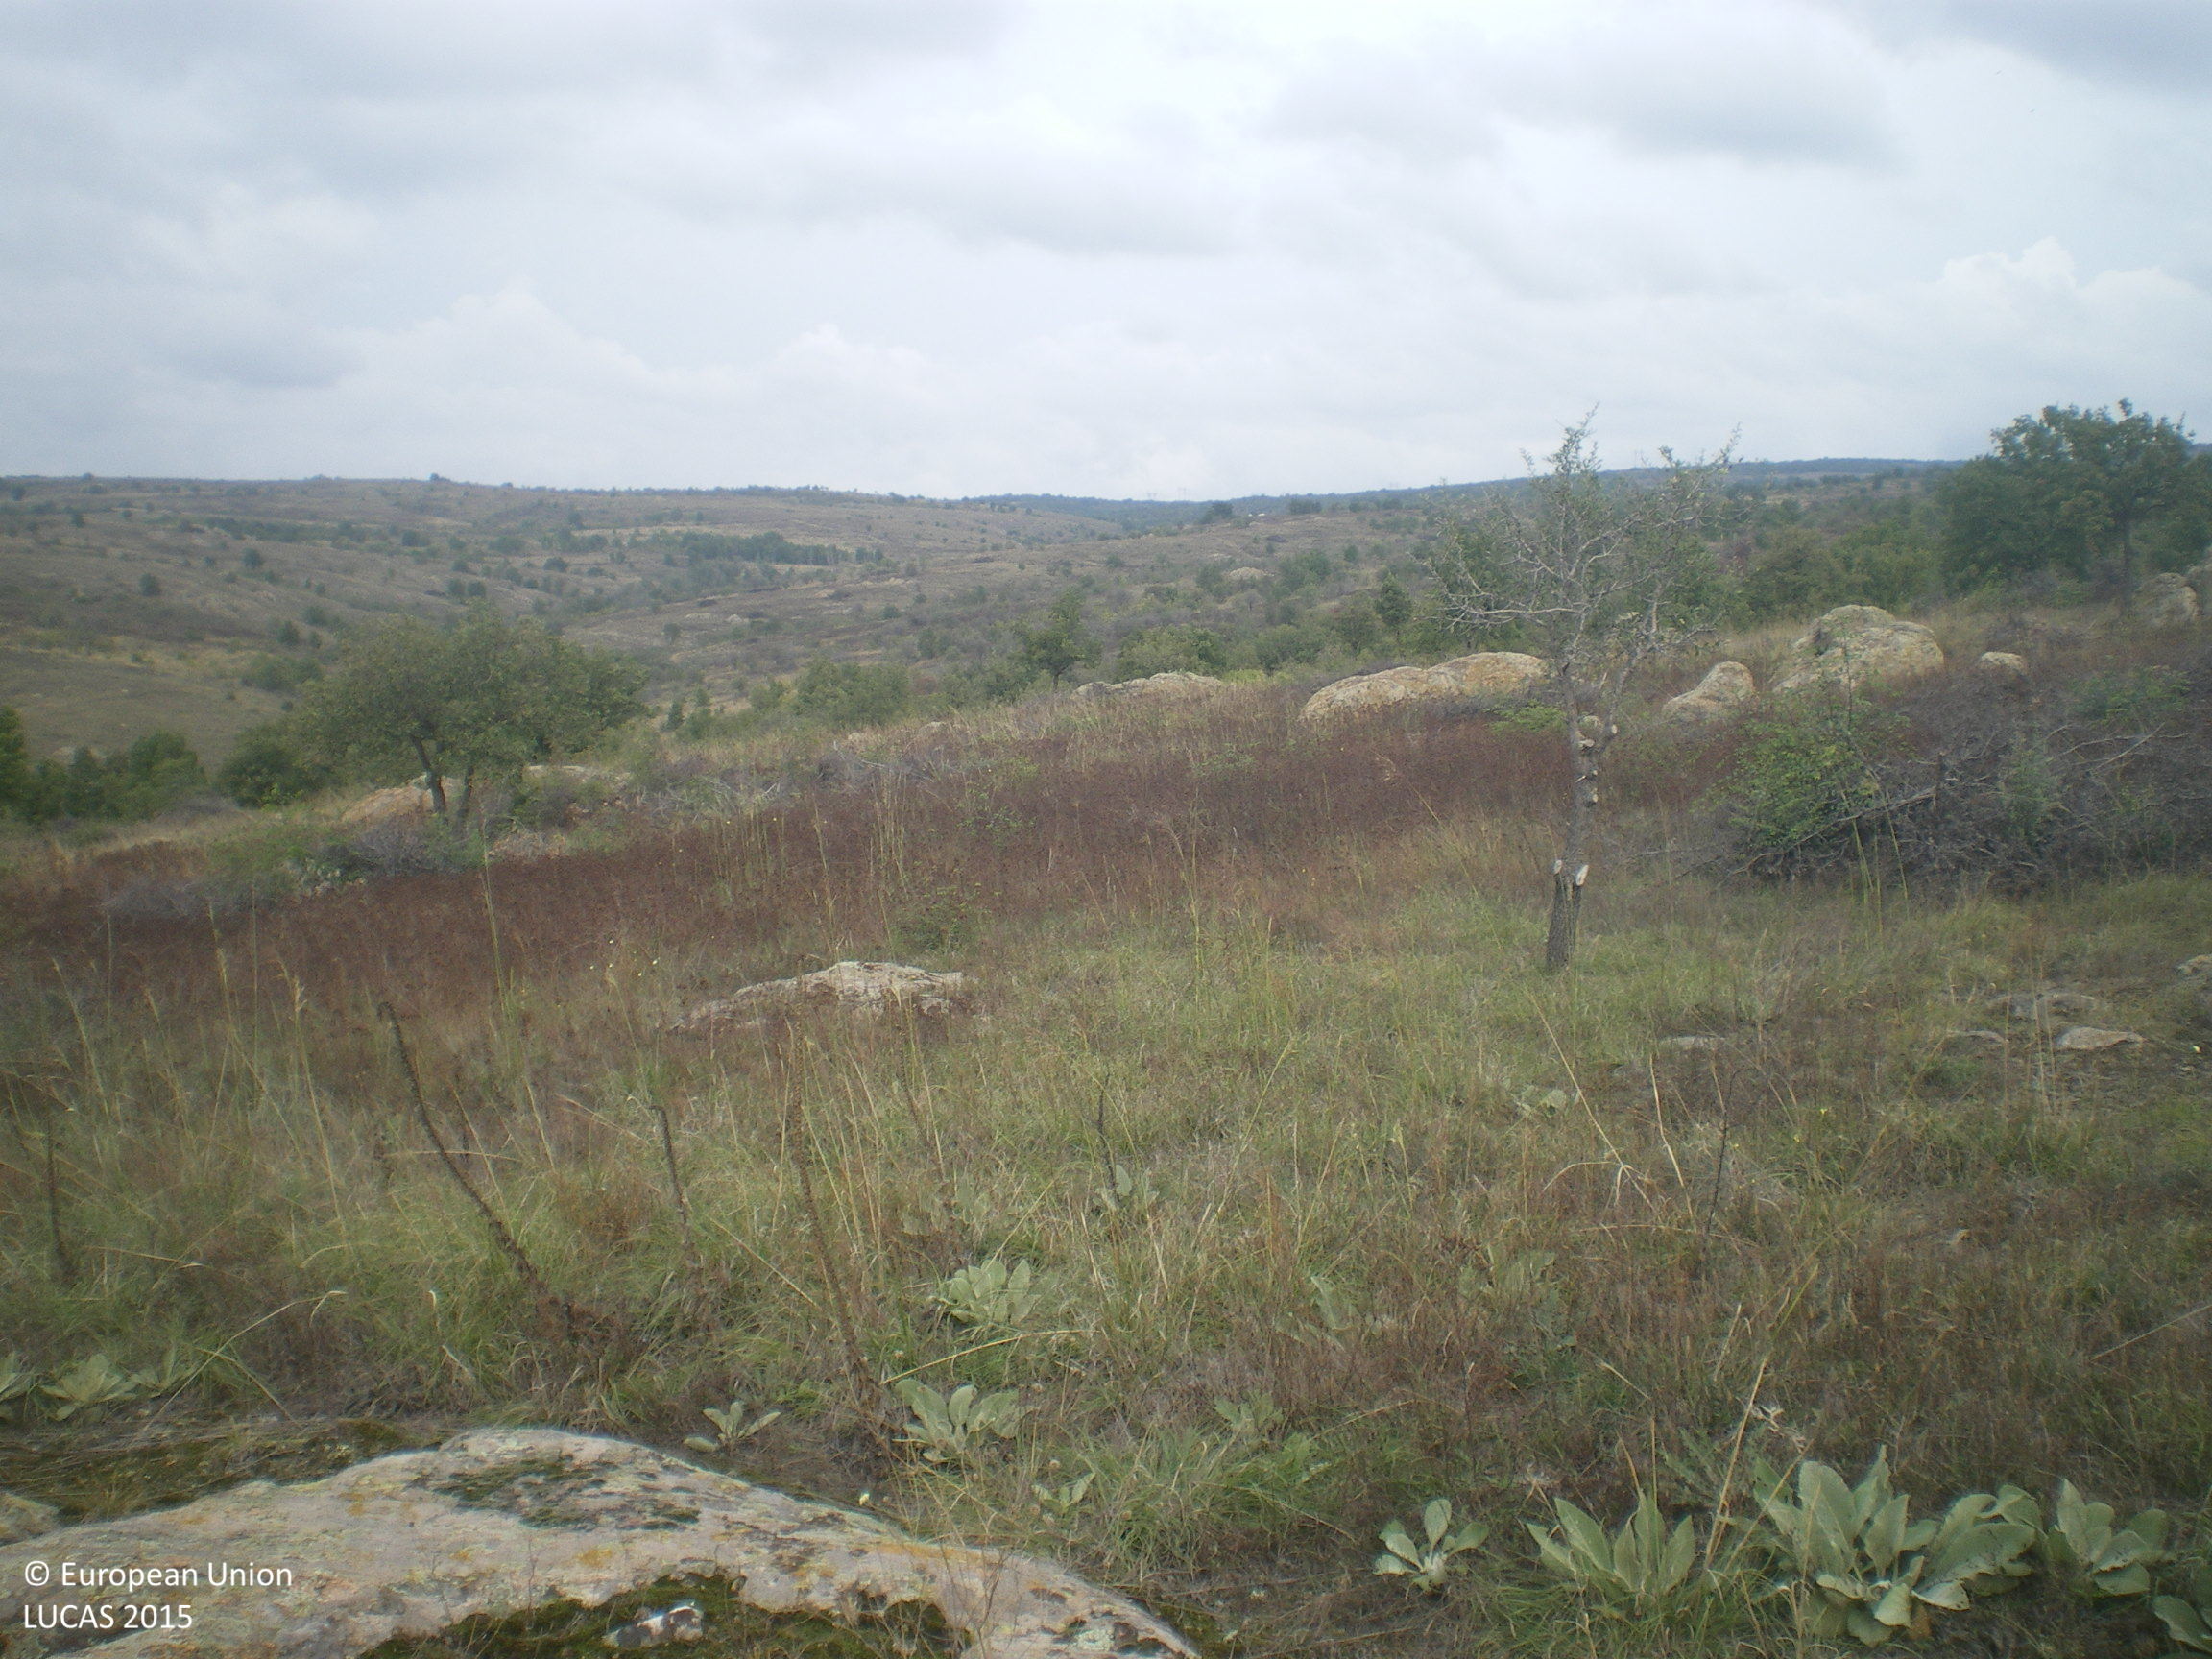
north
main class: Grassland
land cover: Grassland with sparse tree/shrub cover
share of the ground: > 75 %
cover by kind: herbaceous plants 85 %, shrubs 10 %, broadleaved forest trees 5 %
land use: Agriculture (excluding fallow land and kitchen gardens)
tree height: > 5 m
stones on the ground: < 10 %
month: October
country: BG
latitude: 41.9723
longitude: 26.0404
